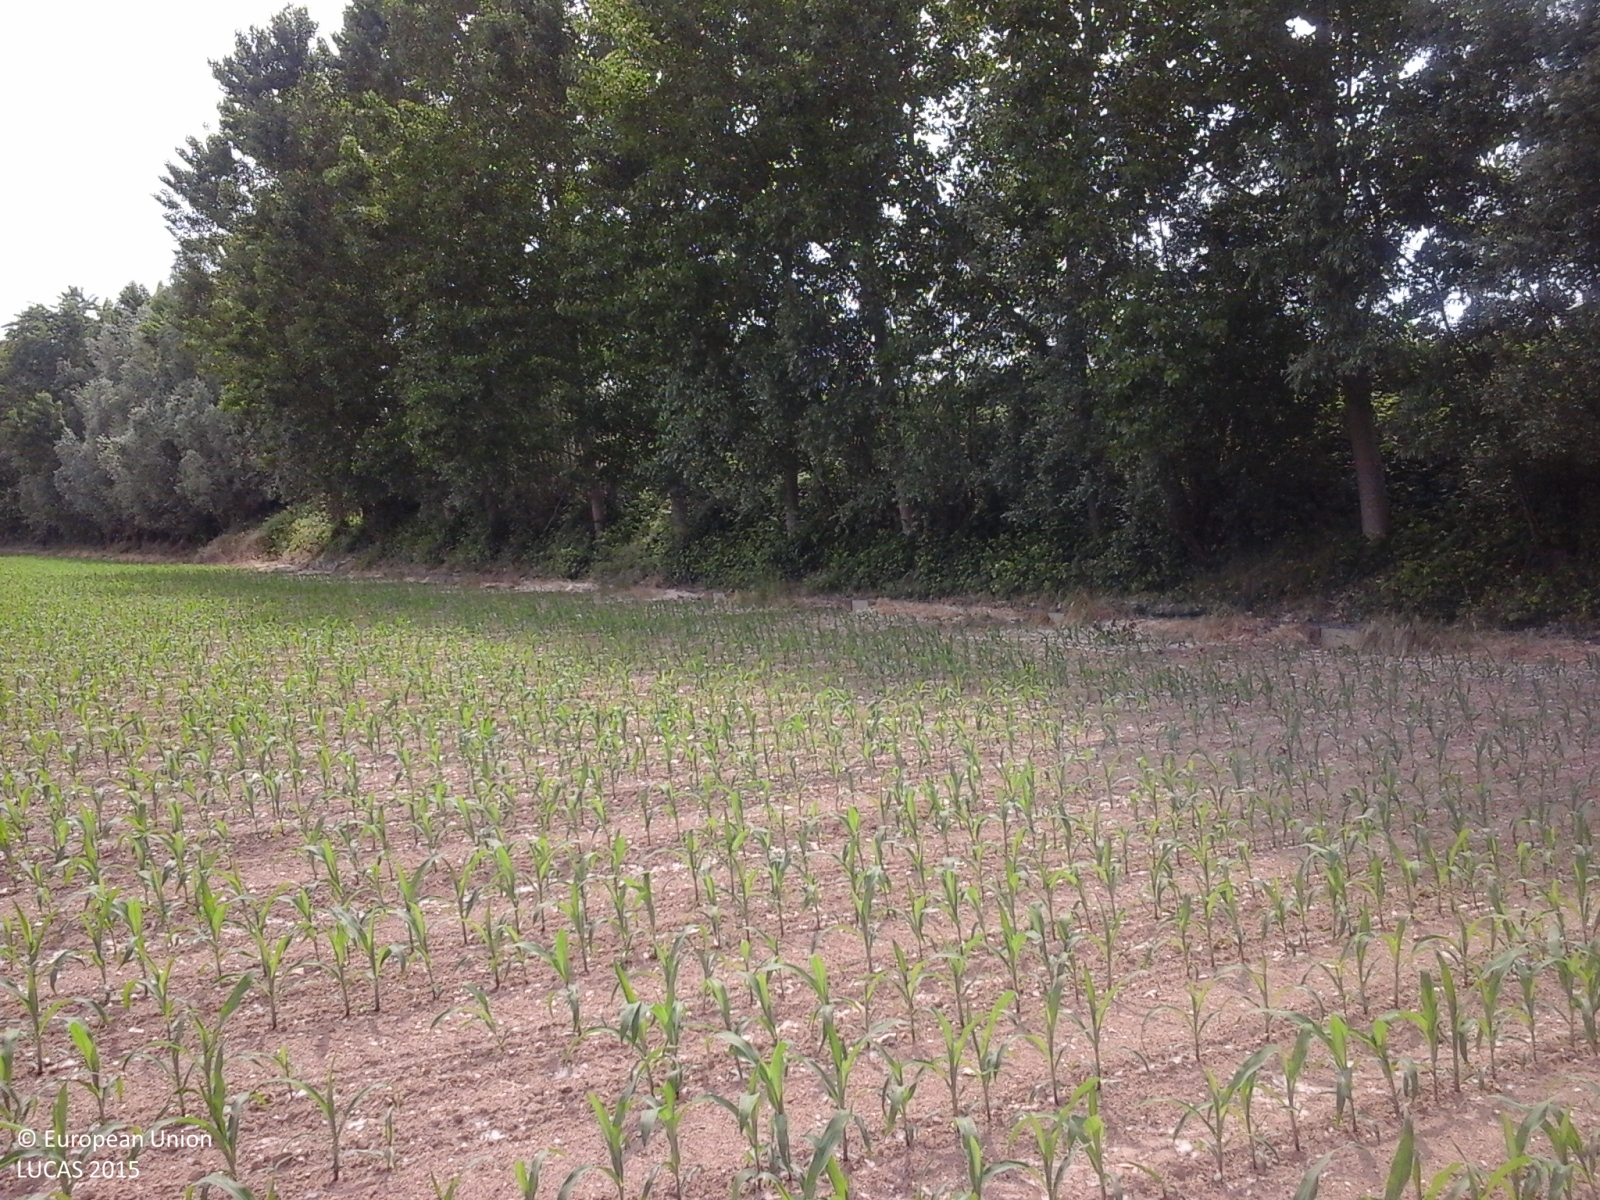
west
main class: Cropland
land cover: Maize
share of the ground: 25 - 50 %
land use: Agriculture (excluding fallow land and kitchen gardens)
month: May
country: IT
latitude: 45.2881
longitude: 10.0636
